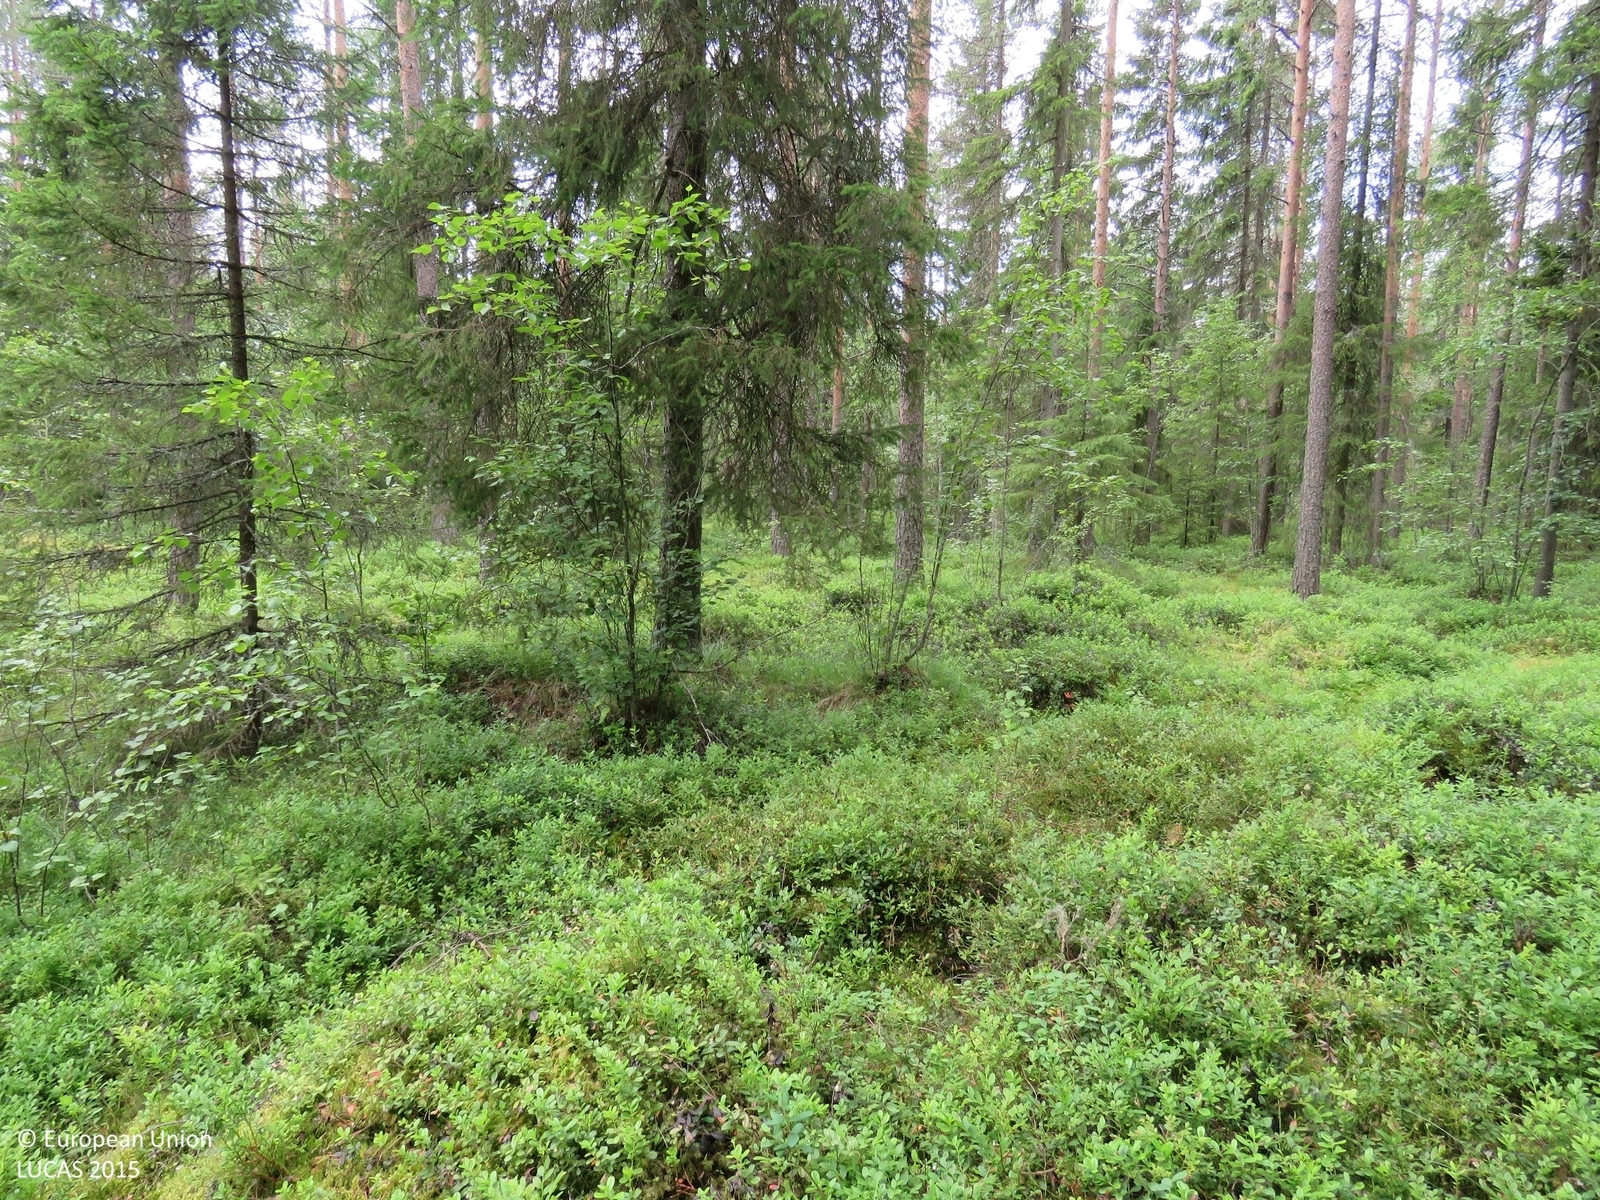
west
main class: Woodland
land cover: Spruce dominated coniferous woodland
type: boreal forest
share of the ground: > 75 %
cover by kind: coniferous forest trees 75 %, shrubs 15 %, broadleaved forest trees 10 %
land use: Forestry
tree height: > 5 m
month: July
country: FI
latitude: 64.4686
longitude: 26.5225
